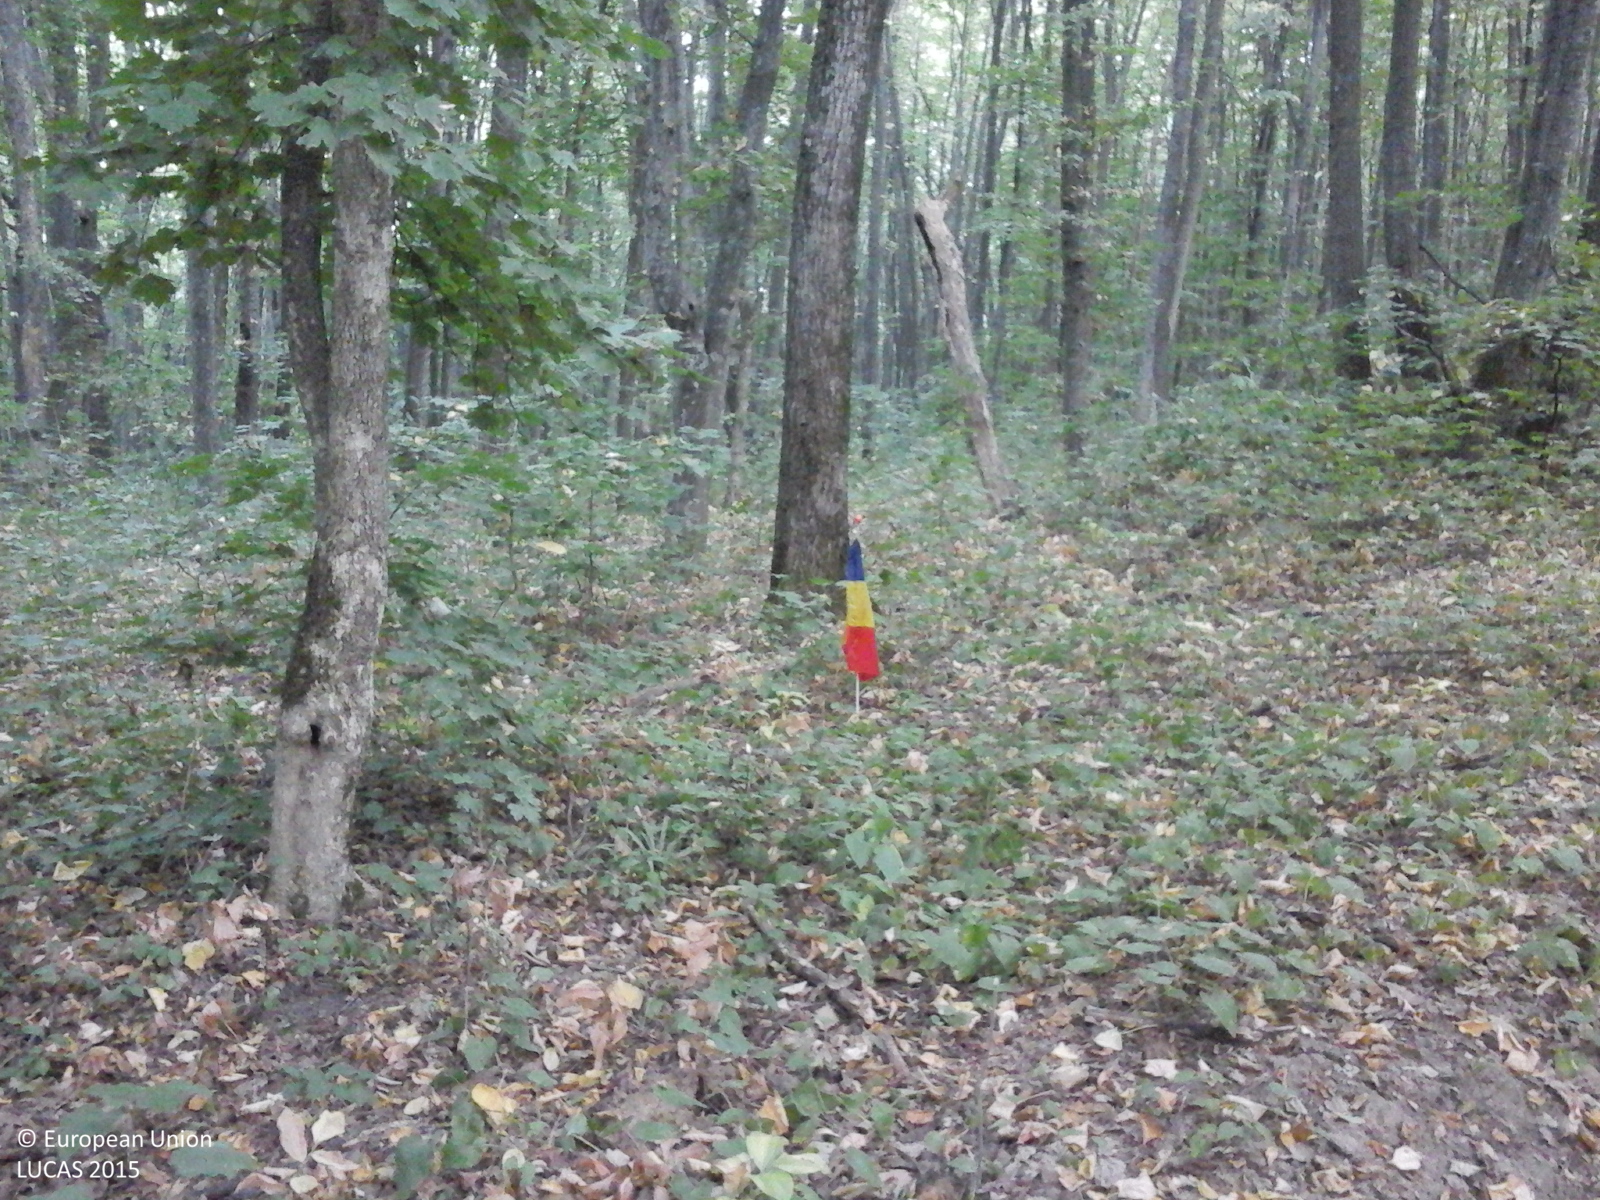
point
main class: Woodland
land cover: Broadleaved woodland
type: mesophytic deciduous forest
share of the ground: > 75 %
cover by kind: broadleaved forest trees 100 %
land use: Forestry
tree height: > 5 m
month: July
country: RO
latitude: 45.1818
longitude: 28.3892
